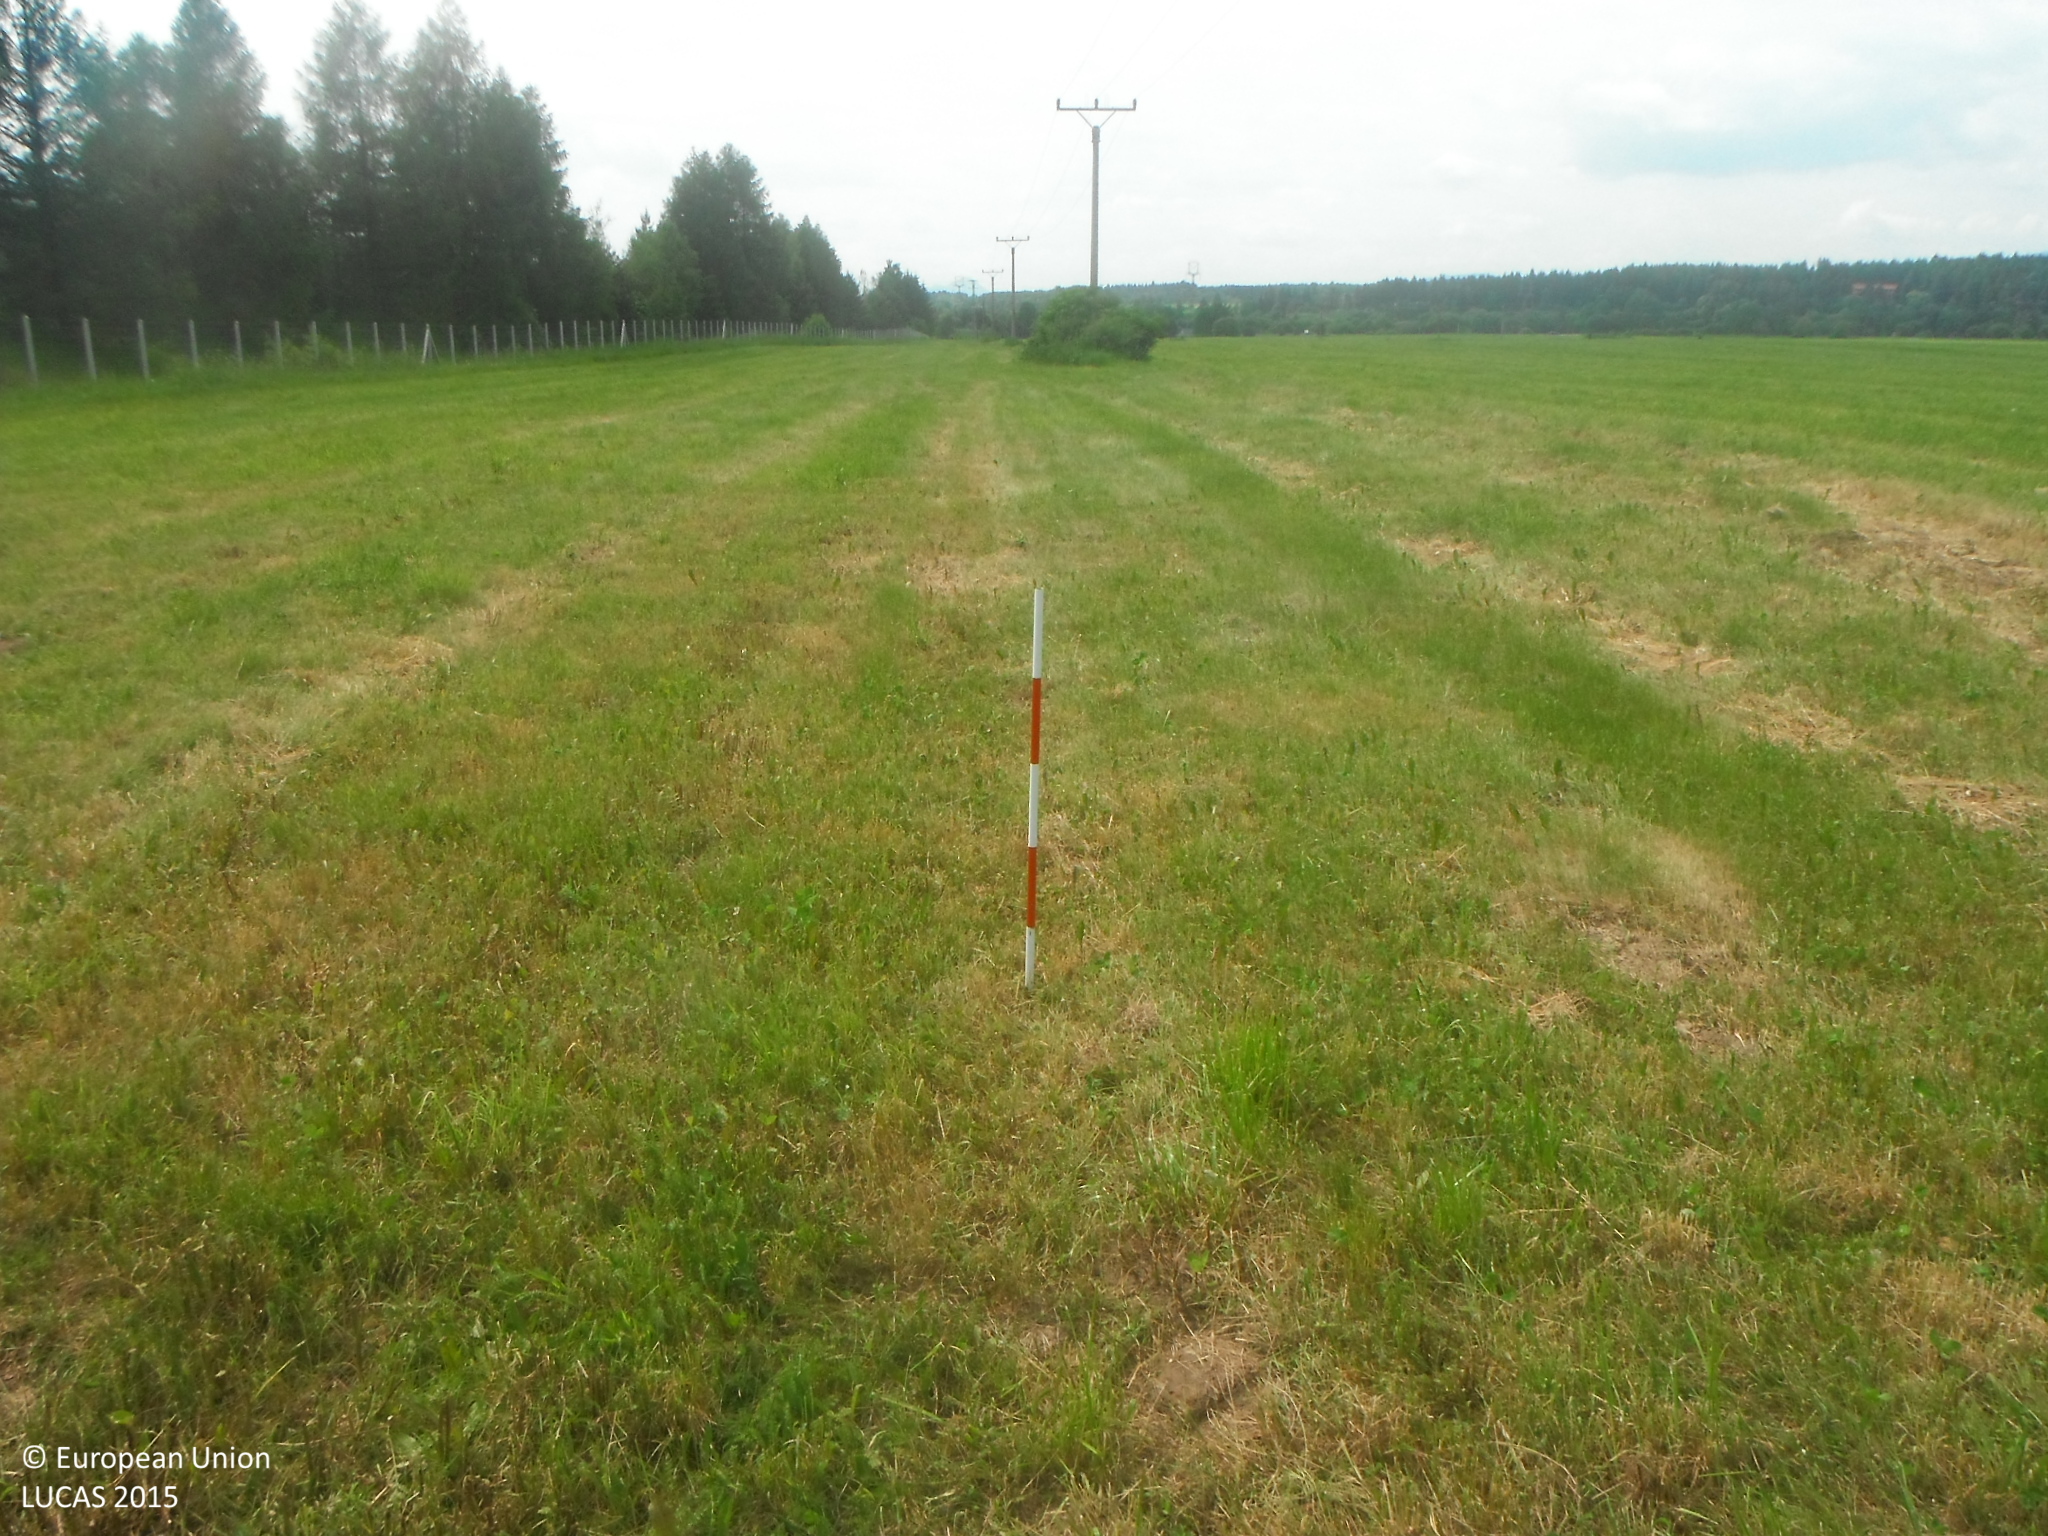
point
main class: Grassland
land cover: Grassland without tree/shrub cover
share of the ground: > 75 %
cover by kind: herbaceous plants 100 %
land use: Agriculture (excluding fallow land and kitchen gardens)
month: June
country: SK
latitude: 49.0581
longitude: 19.7583
